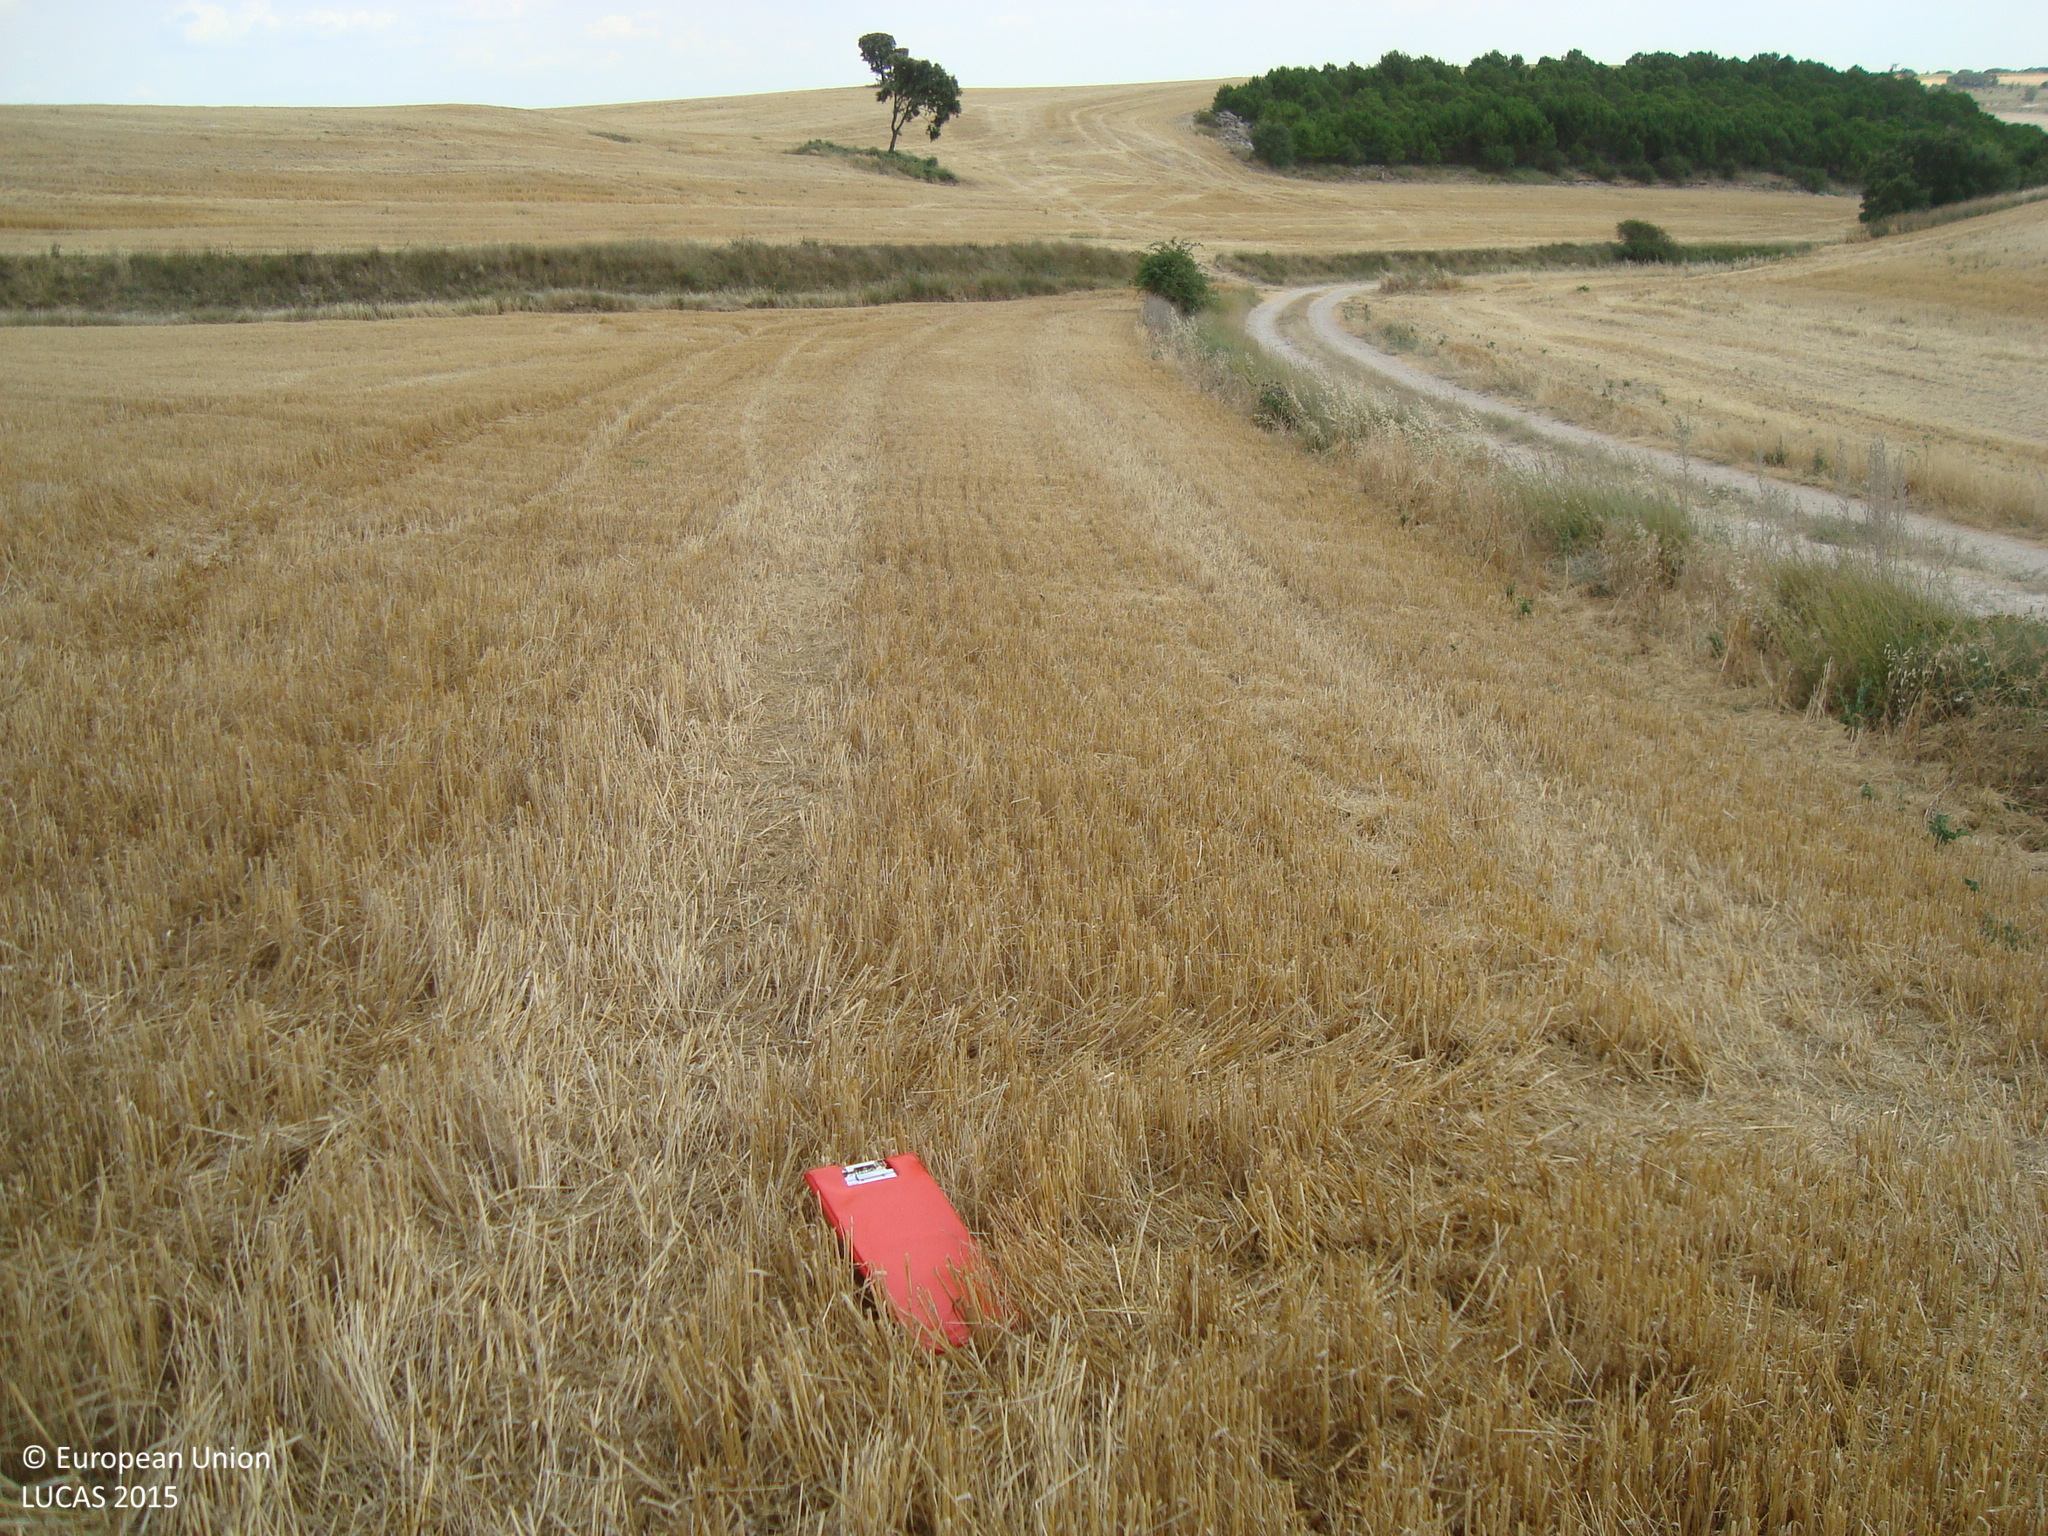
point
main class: Cropland
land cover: Barley
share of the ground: > 75 %
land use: Agriculture (excluding fallow land and kitchen gardens)
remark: Harvested field
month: July
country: ES
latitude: 41.9559
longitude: -4.0932
